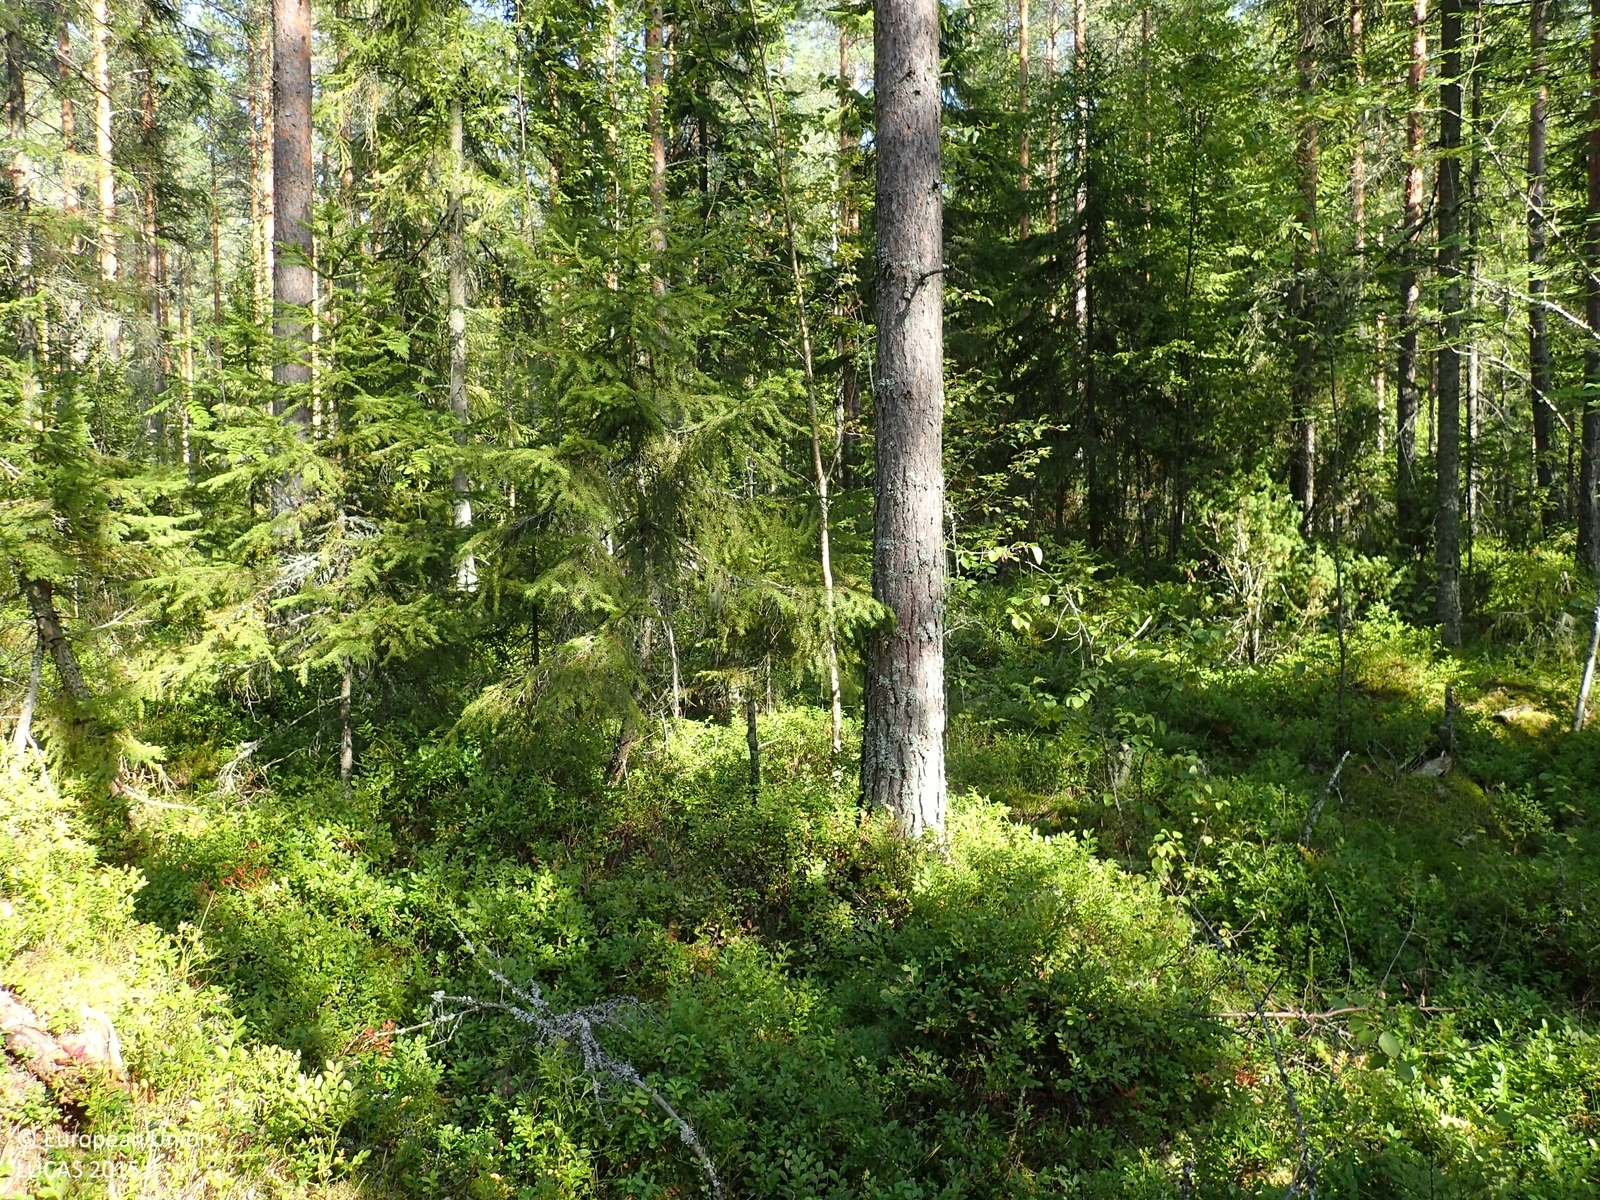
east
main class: Woodland
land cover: Other coniferous woodland
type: boreal forest
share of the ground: > 75 %
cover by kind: coniferous forest trees 65 %, shrubs 20 %, broadleaved forest trees 10 %, lichens and mosses 5 %
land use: Forestry
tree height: > 5 m
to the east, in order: Other coniferous woodland; Ditches and canals; Grass margins; Paved roads, cycling and walking lanes; Grass margins; Ditches and canals; Other coniferous woodland; Pine dominated coniferous woodland
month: August
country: FI
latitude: 62.6494
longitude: 22.3636
